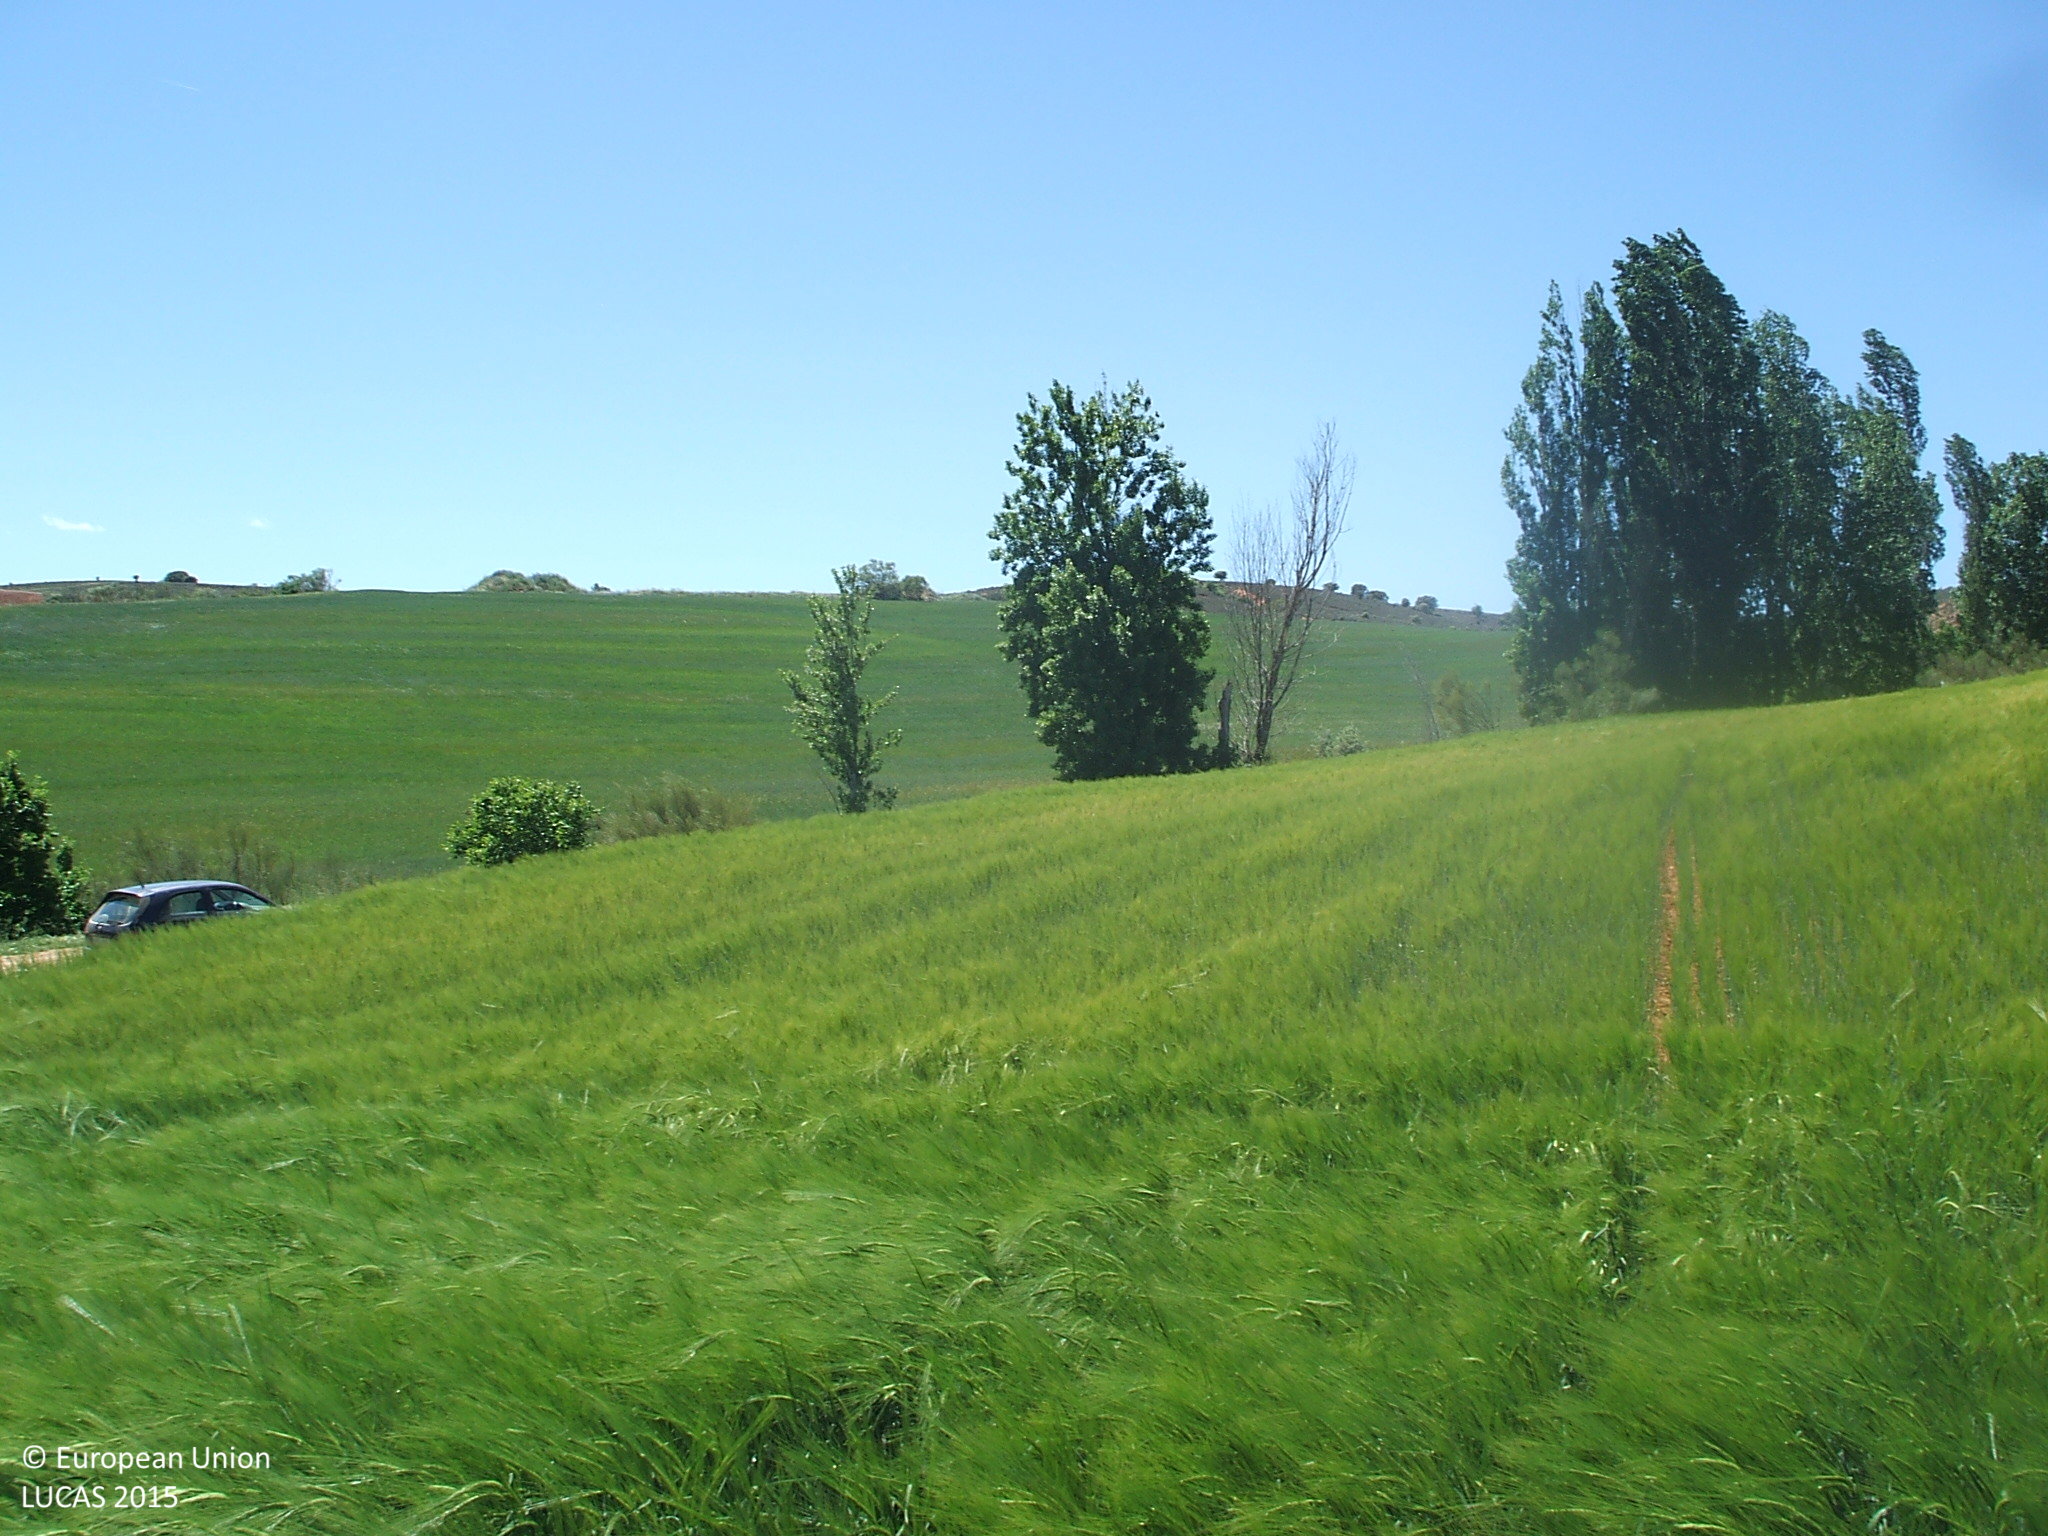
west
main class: Cropland
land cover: Barley
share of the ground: > 75 %
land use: Agriculture (excluding fallow land and kitchen gardens)
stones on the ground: > 50 %
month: May
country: ES
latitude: 40.9537
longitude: -2.9965
